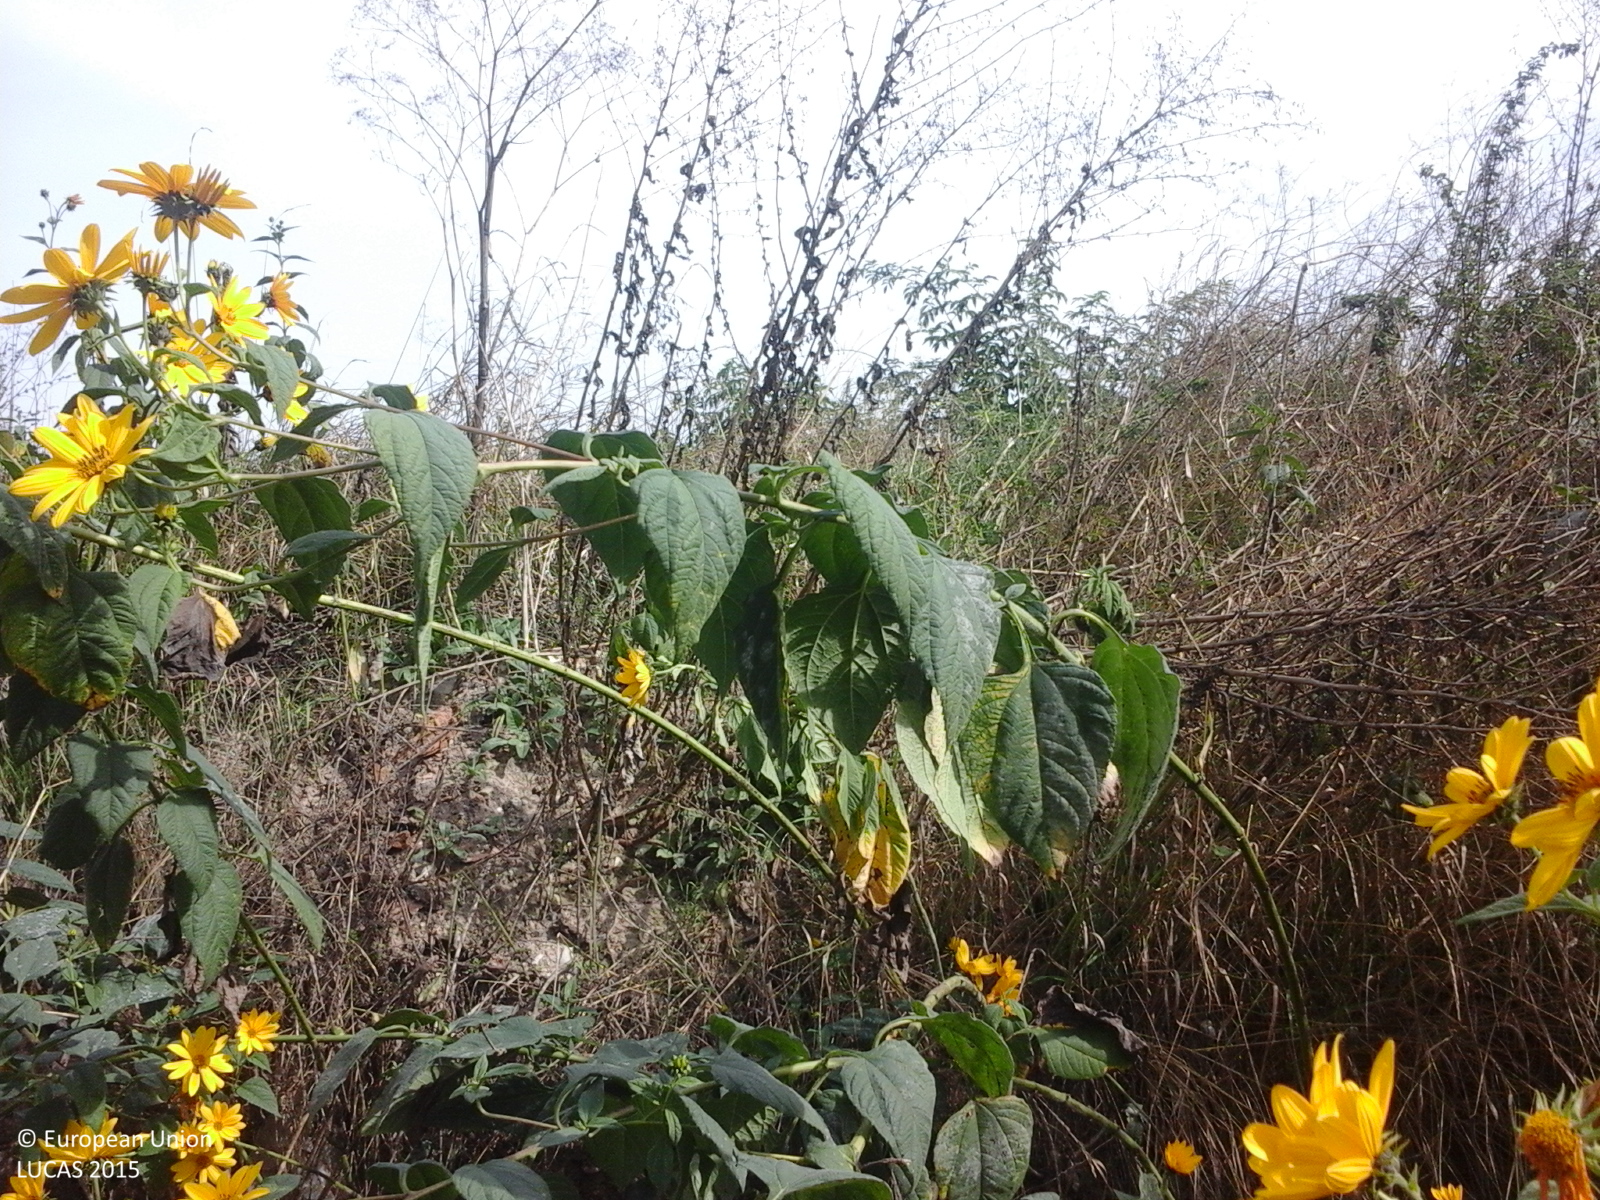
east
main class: Shrubland
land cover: Shrubland with sparse tree cover
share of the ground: > 75 %
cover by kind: shrubs 95 %, broadleaved forest trees 5 %
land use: Semi-natural and natural areas not in use
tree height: > 5 m
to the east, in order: Shrubland with sparse tree cover; Spontaneously vegetated surfaces; Tracks; Spontaneously vegetated surfaces; Electric lines; Spontaneously vegetated surfaces; Tracks; Grass margins; Other leguminous and mixtures for fodder
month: September
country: RO
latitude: 47.1816
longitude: 23.9760
